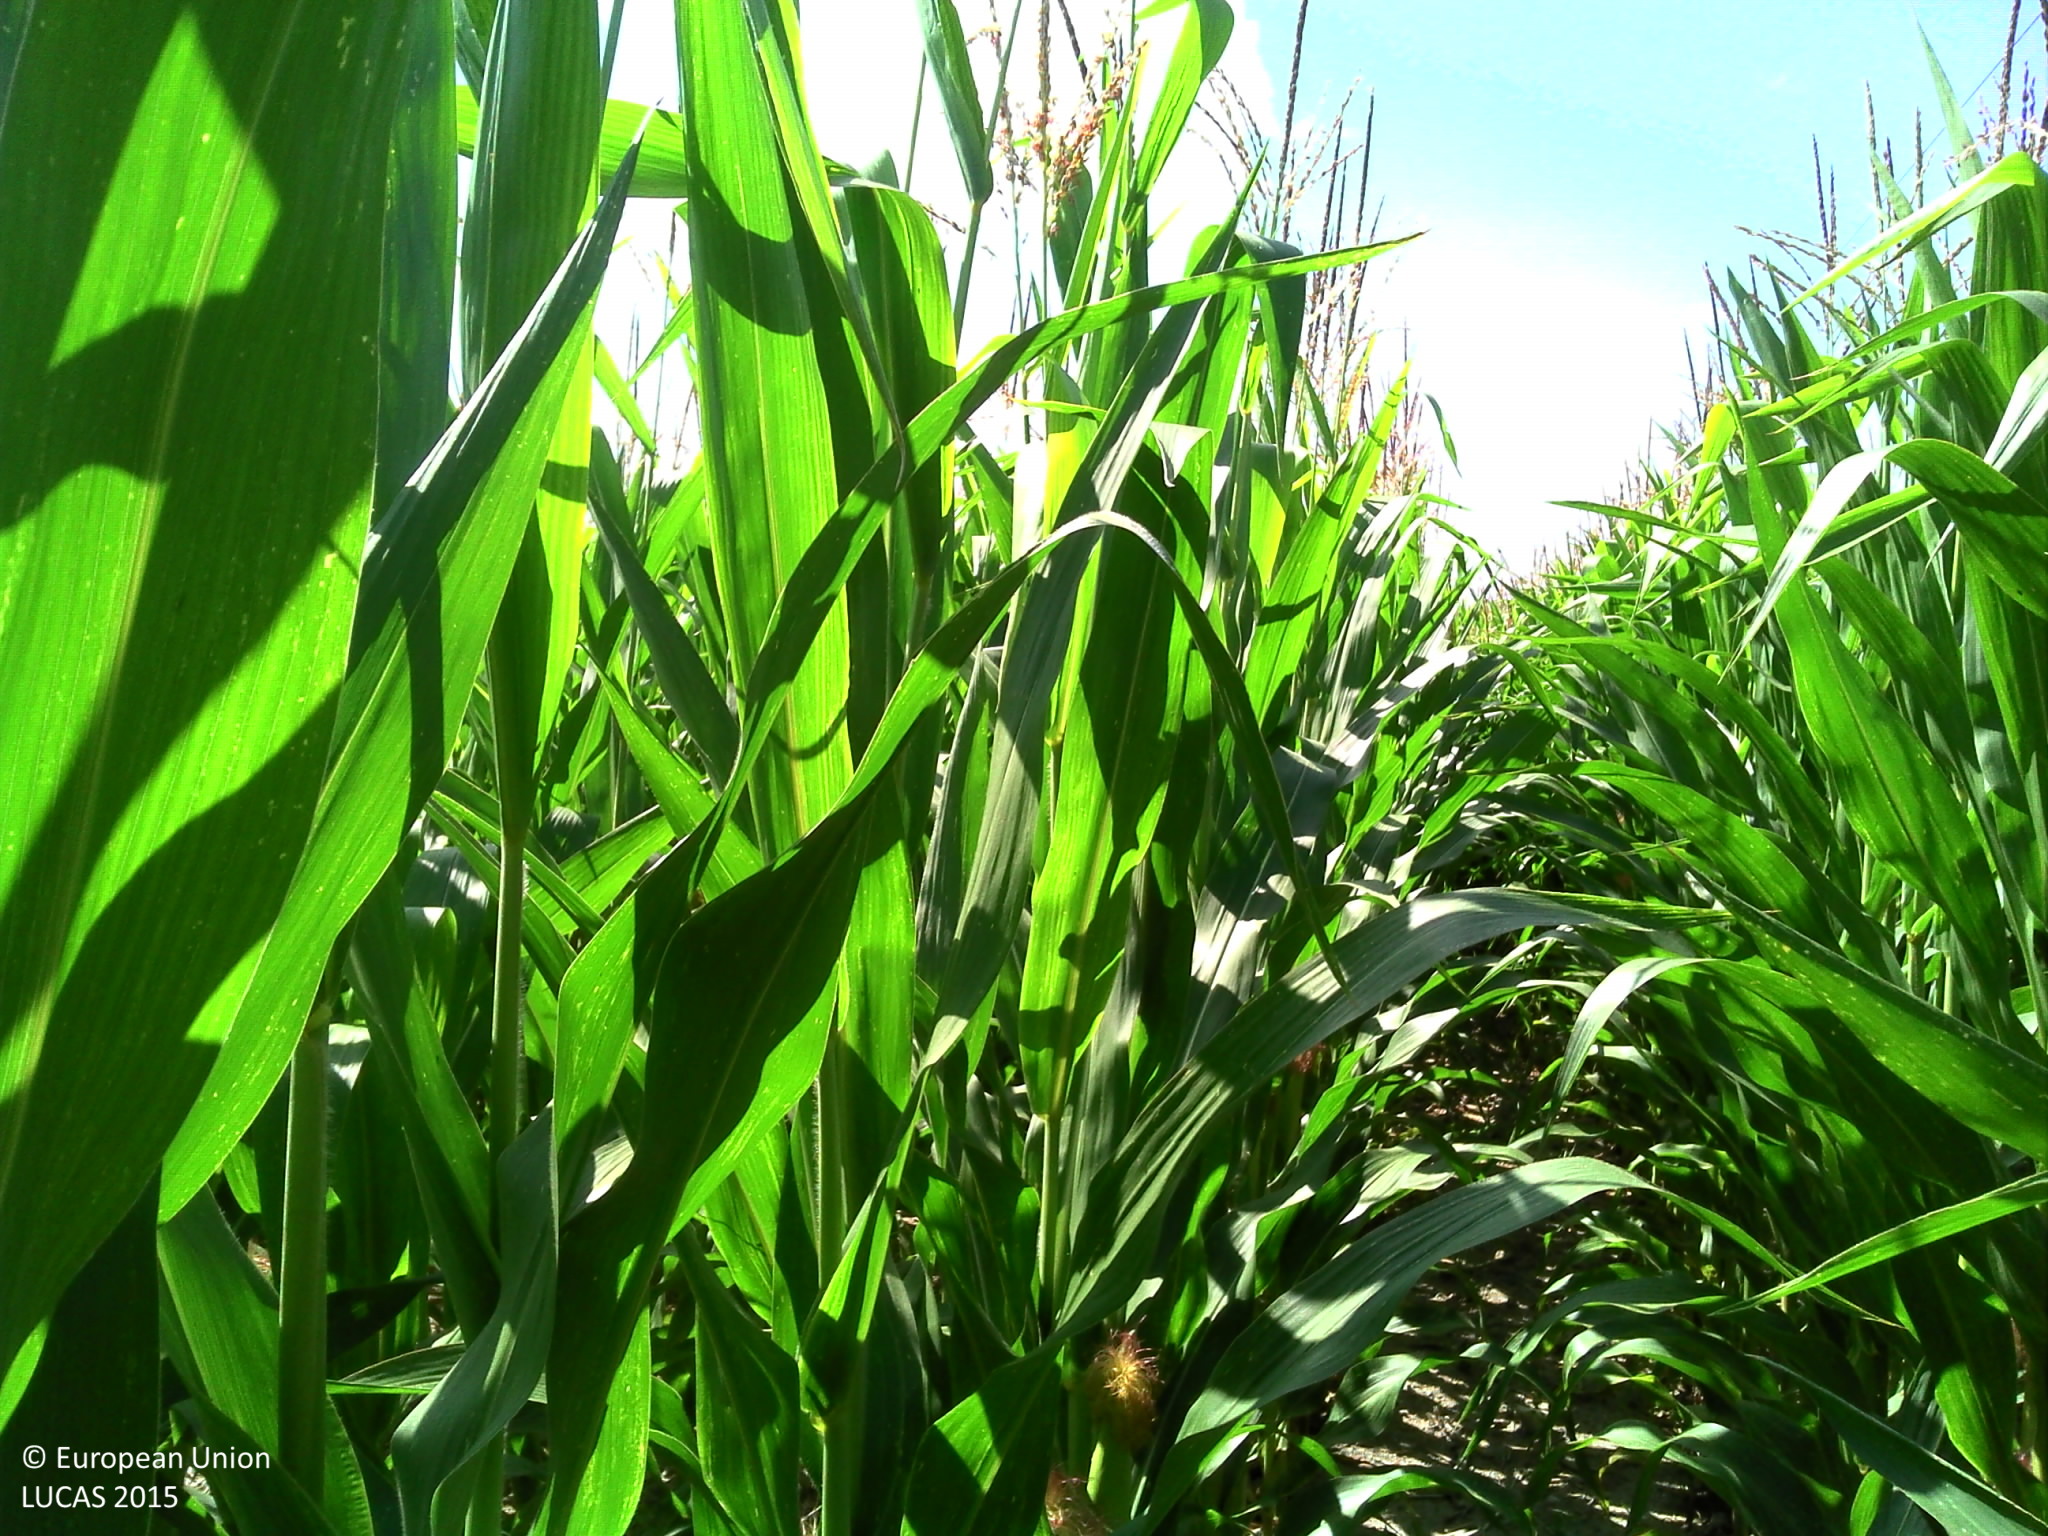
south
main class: Cropland
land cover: Maize
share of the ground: > 75 %
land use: Agriculture (excluding fallow land and kitchen gardens)
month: July
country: FR
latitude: 47.0457
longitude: 2.2394
